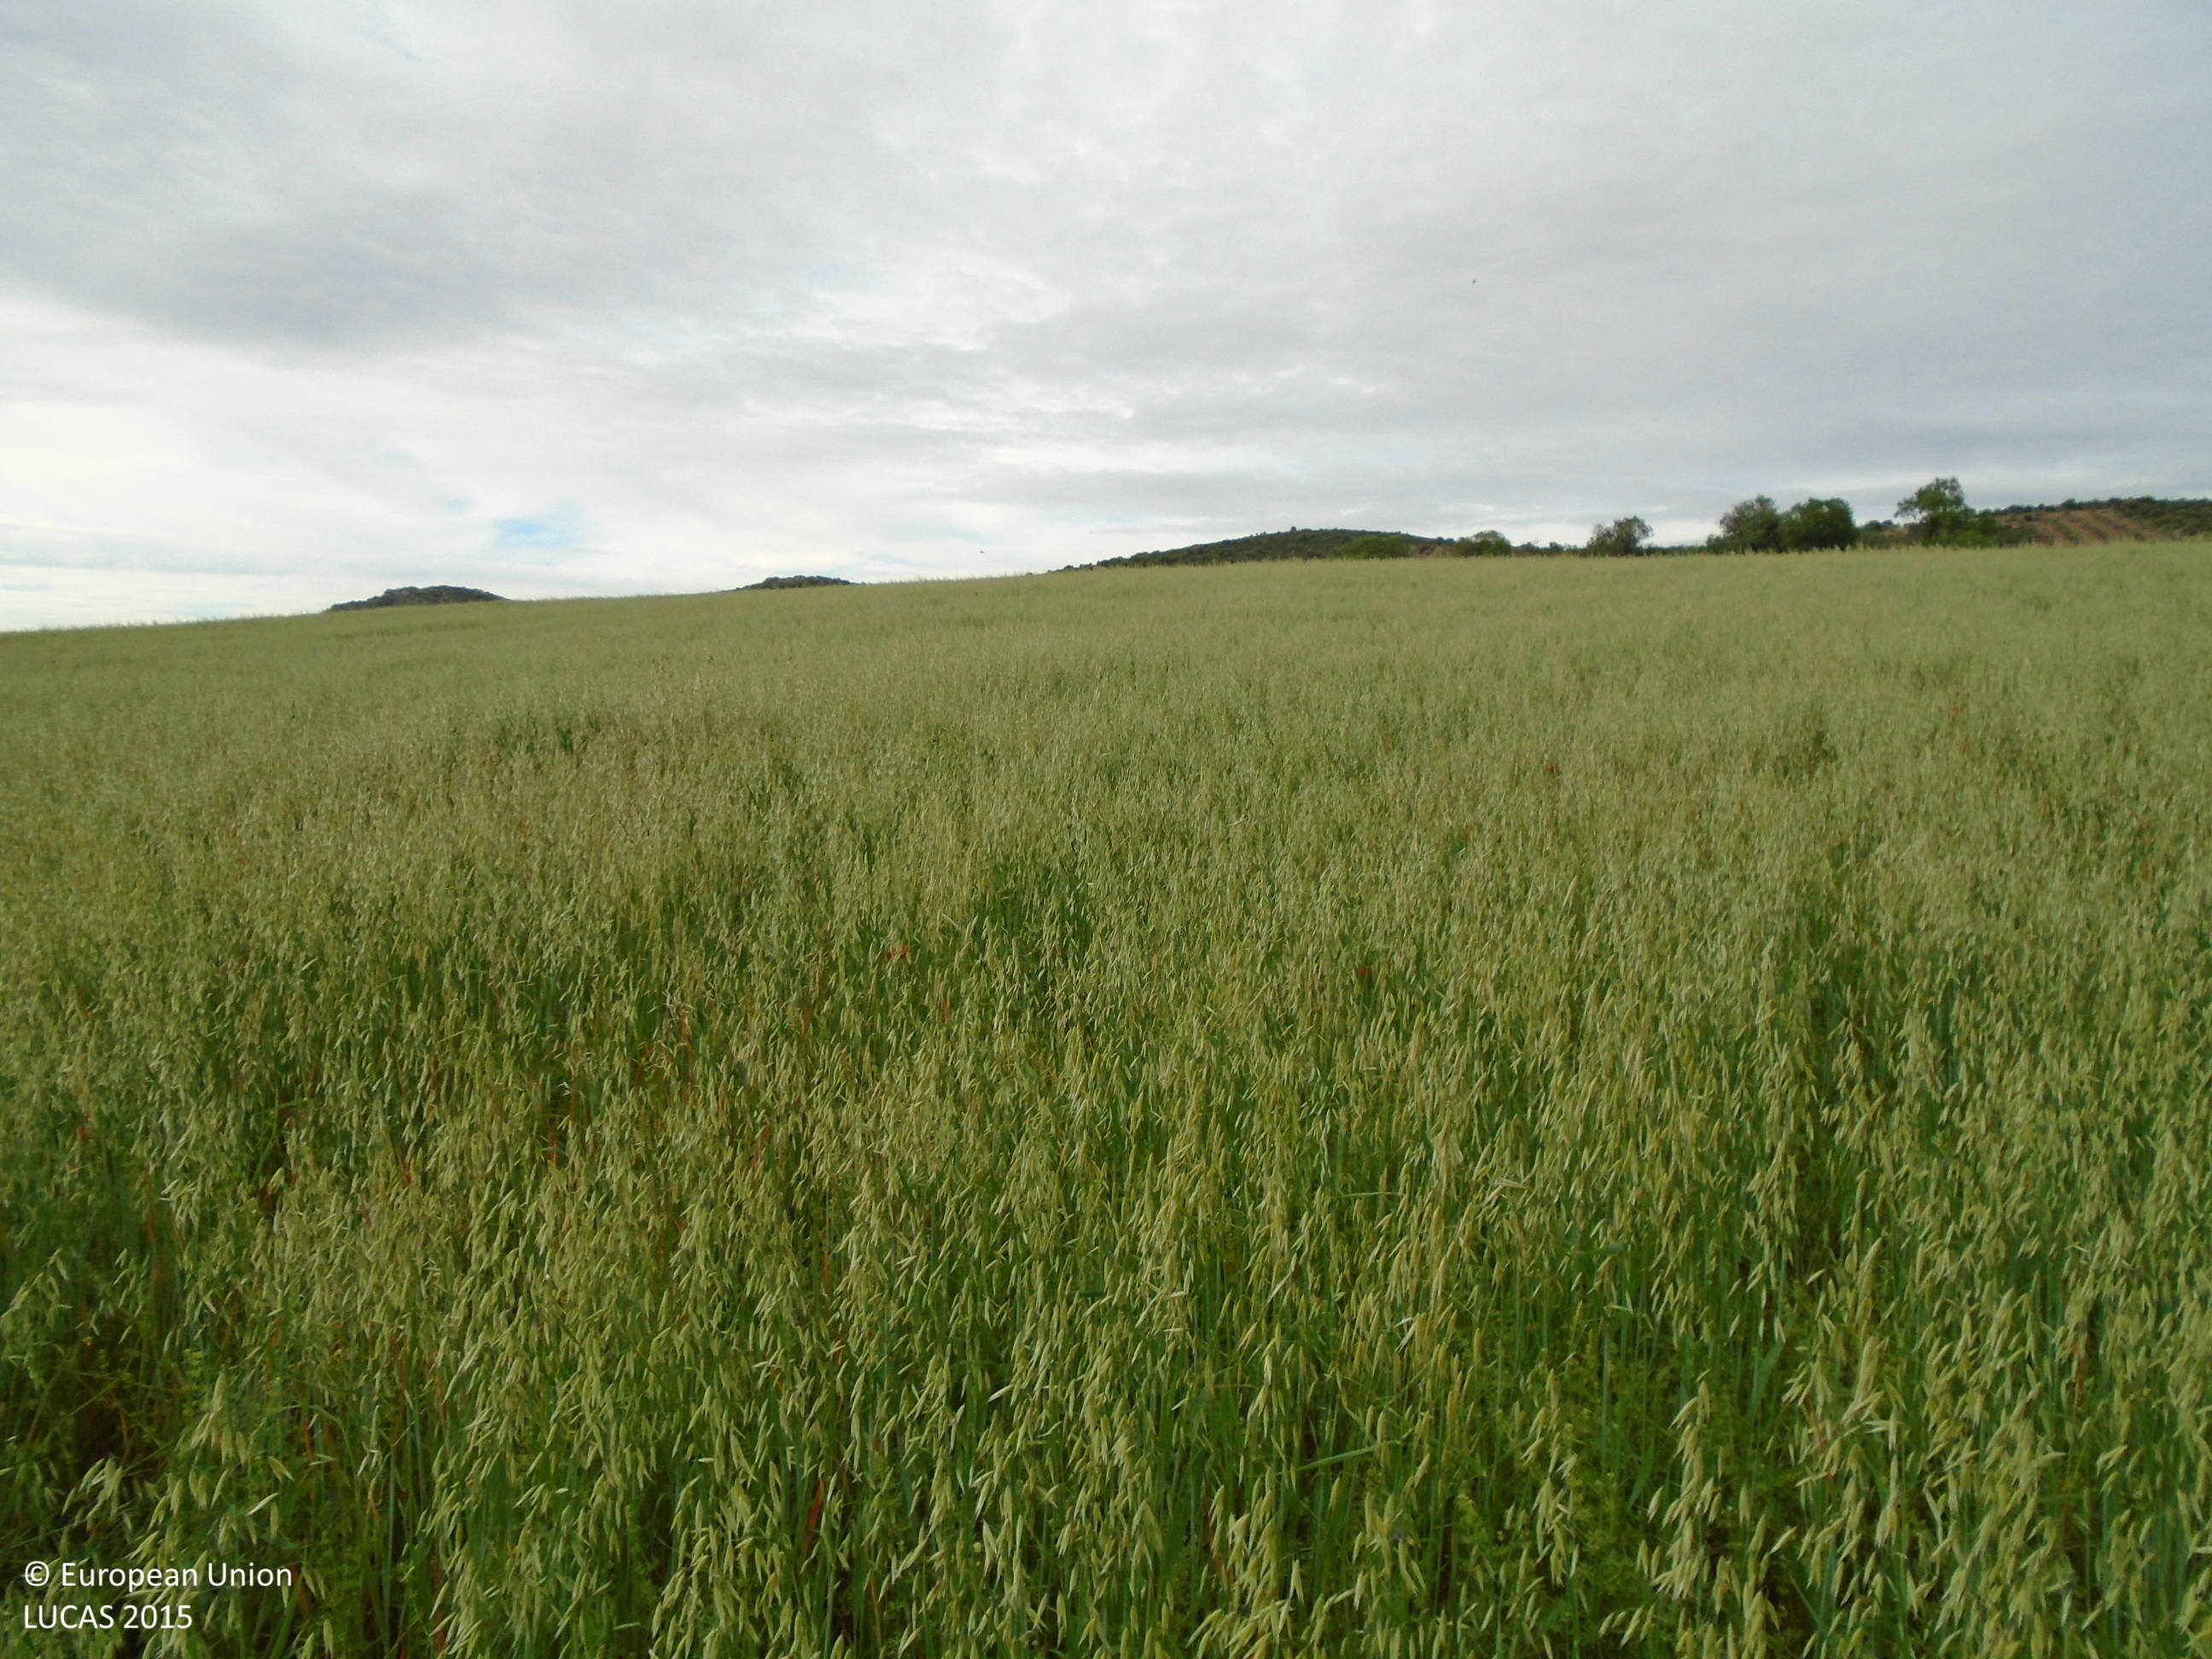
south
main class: Cropland
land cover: Oats
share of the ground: > 75 %
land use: Agriculture (excluding fallow land and kitchen gardens)
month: May
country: ES
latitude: 39.7176
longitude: -4.6108
